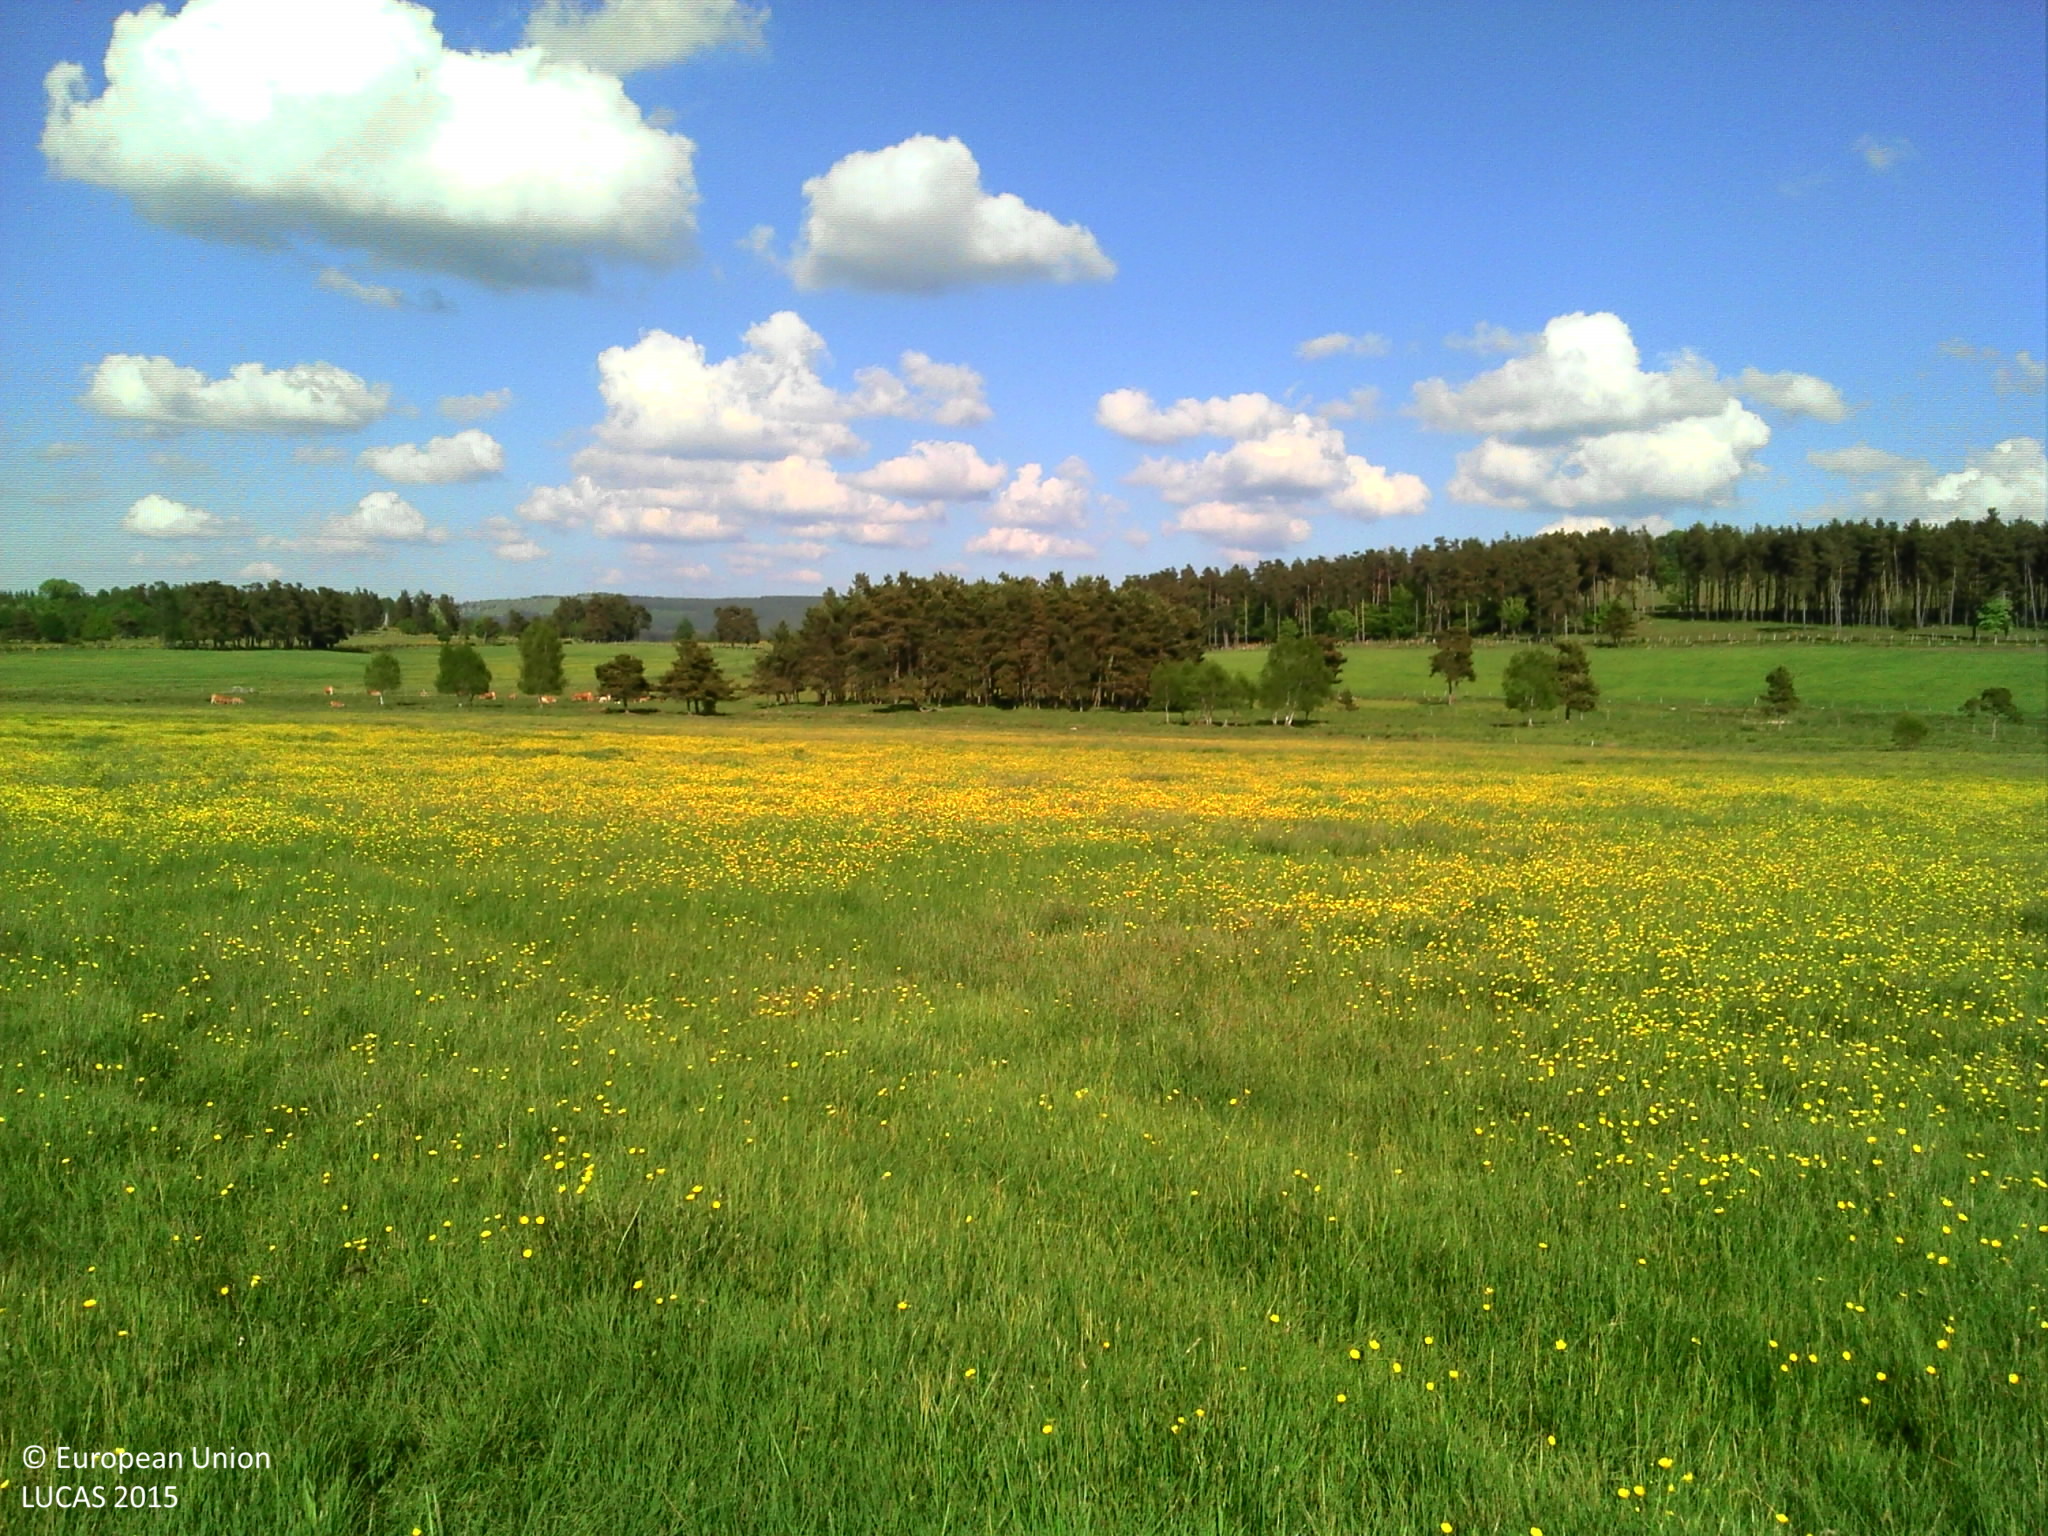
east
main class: Grassland
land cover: Grassland without tree/shrub cover
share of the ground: > 75 %
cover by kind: herbaceous plants 100 %
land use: Agriculture (excluding fallow land and kitchen gardens)
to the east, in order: Grassland without tree/shrub cover; Ditches and canals; Grassland without tree/shrub cover; Rivers and streams; Fences; Grassland without tree/shrub cover; Rivers and streams; Grassland without tree/shrub cover; Pine dominated coniferous woodland
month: June
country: FR
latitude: 44.7794
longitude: 2.9384
